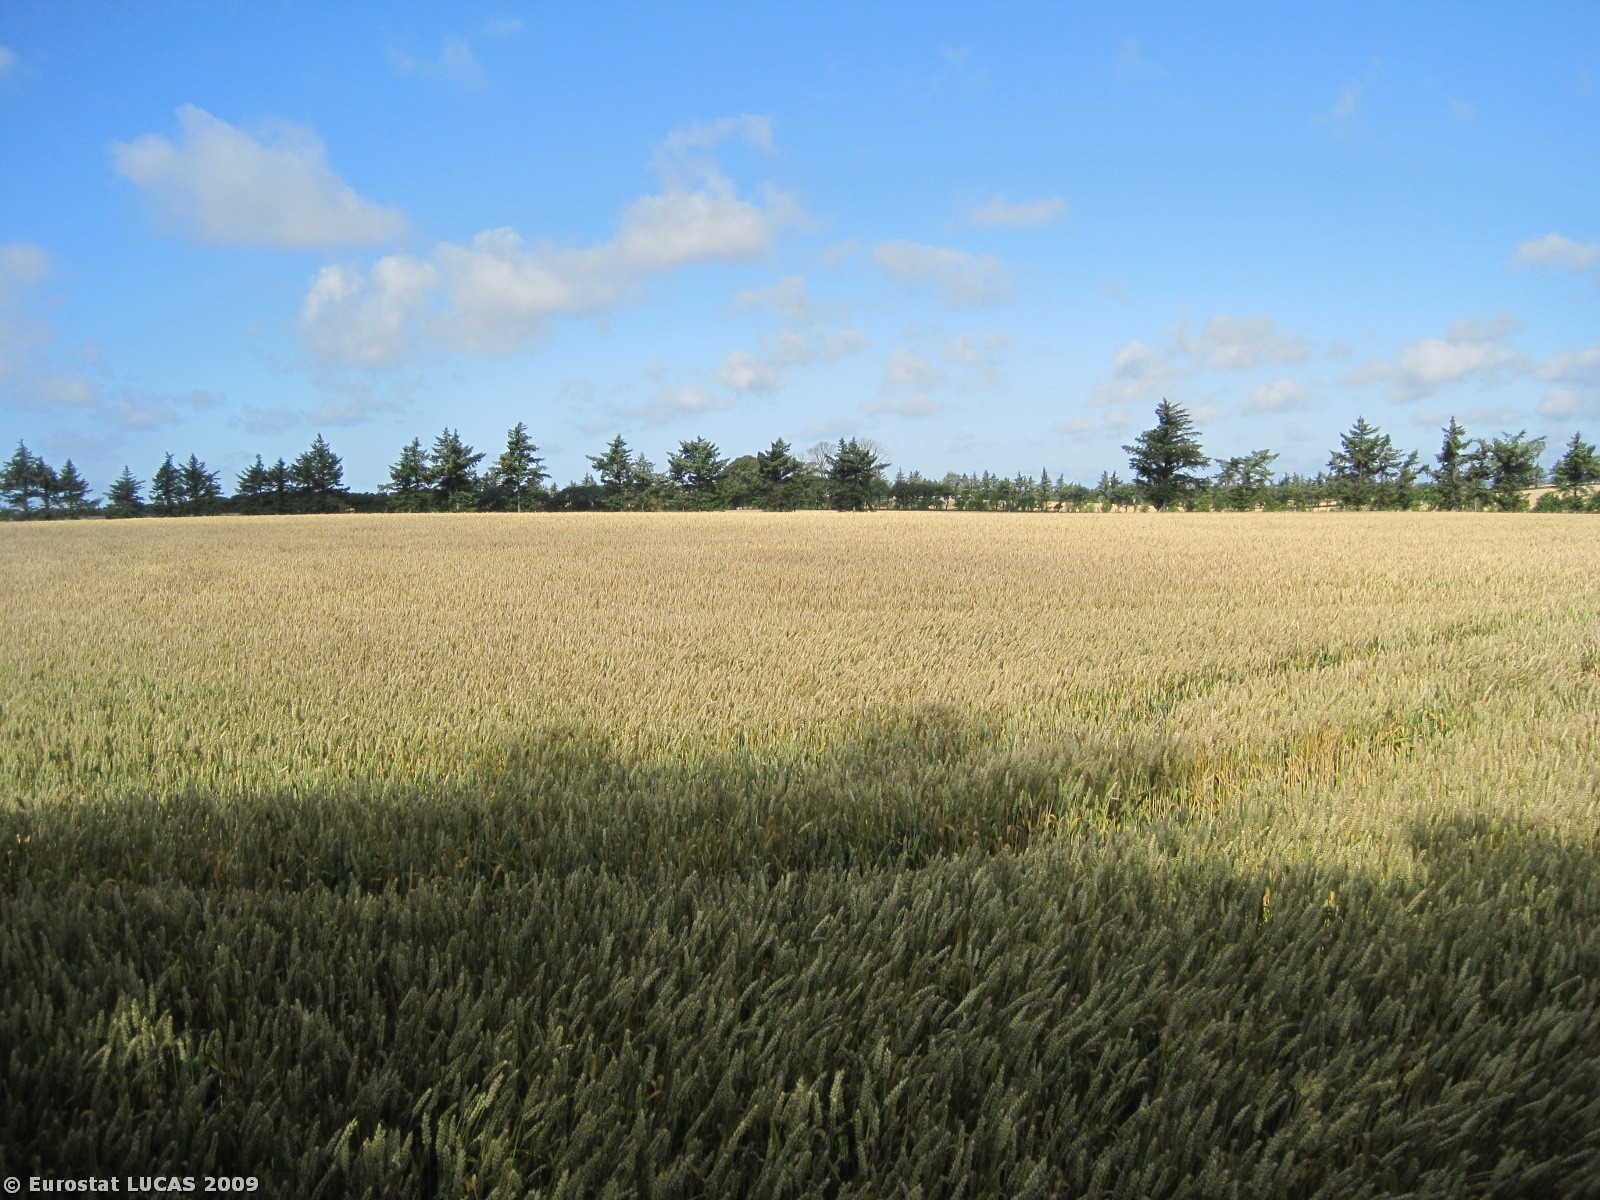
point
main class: Cropland
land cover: Common wheat
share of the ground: > 75 %
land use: Agriculture (excluding fallow land and kitchen gardens)
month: July
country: DK
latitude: 56.7002
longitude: 8.4832
